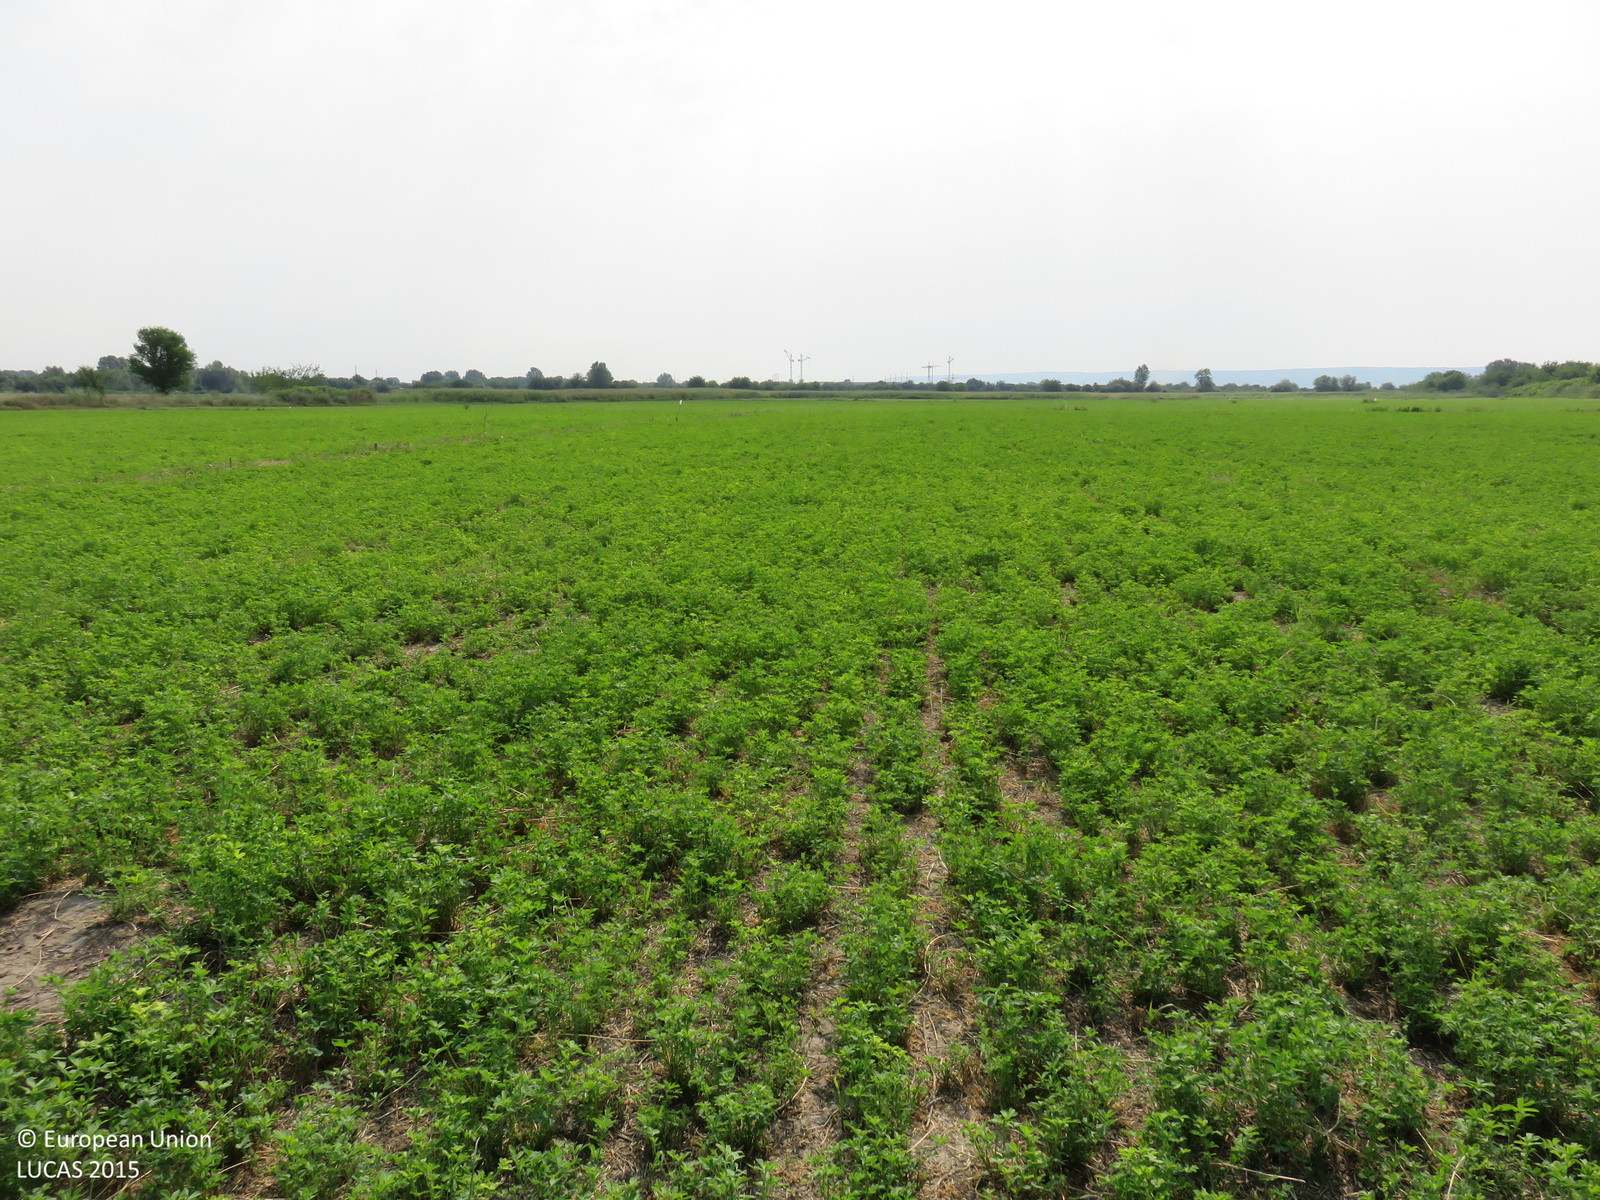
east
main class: Cropland
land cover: Lucerne
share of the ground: > 75 %
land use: Agriculture (excluding fallow land and kitchen gardens)
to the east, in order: Lucerne; Tracks; Grass margins; Lucerne
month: July
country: BG
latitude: 43.6322
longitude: 25.1600
